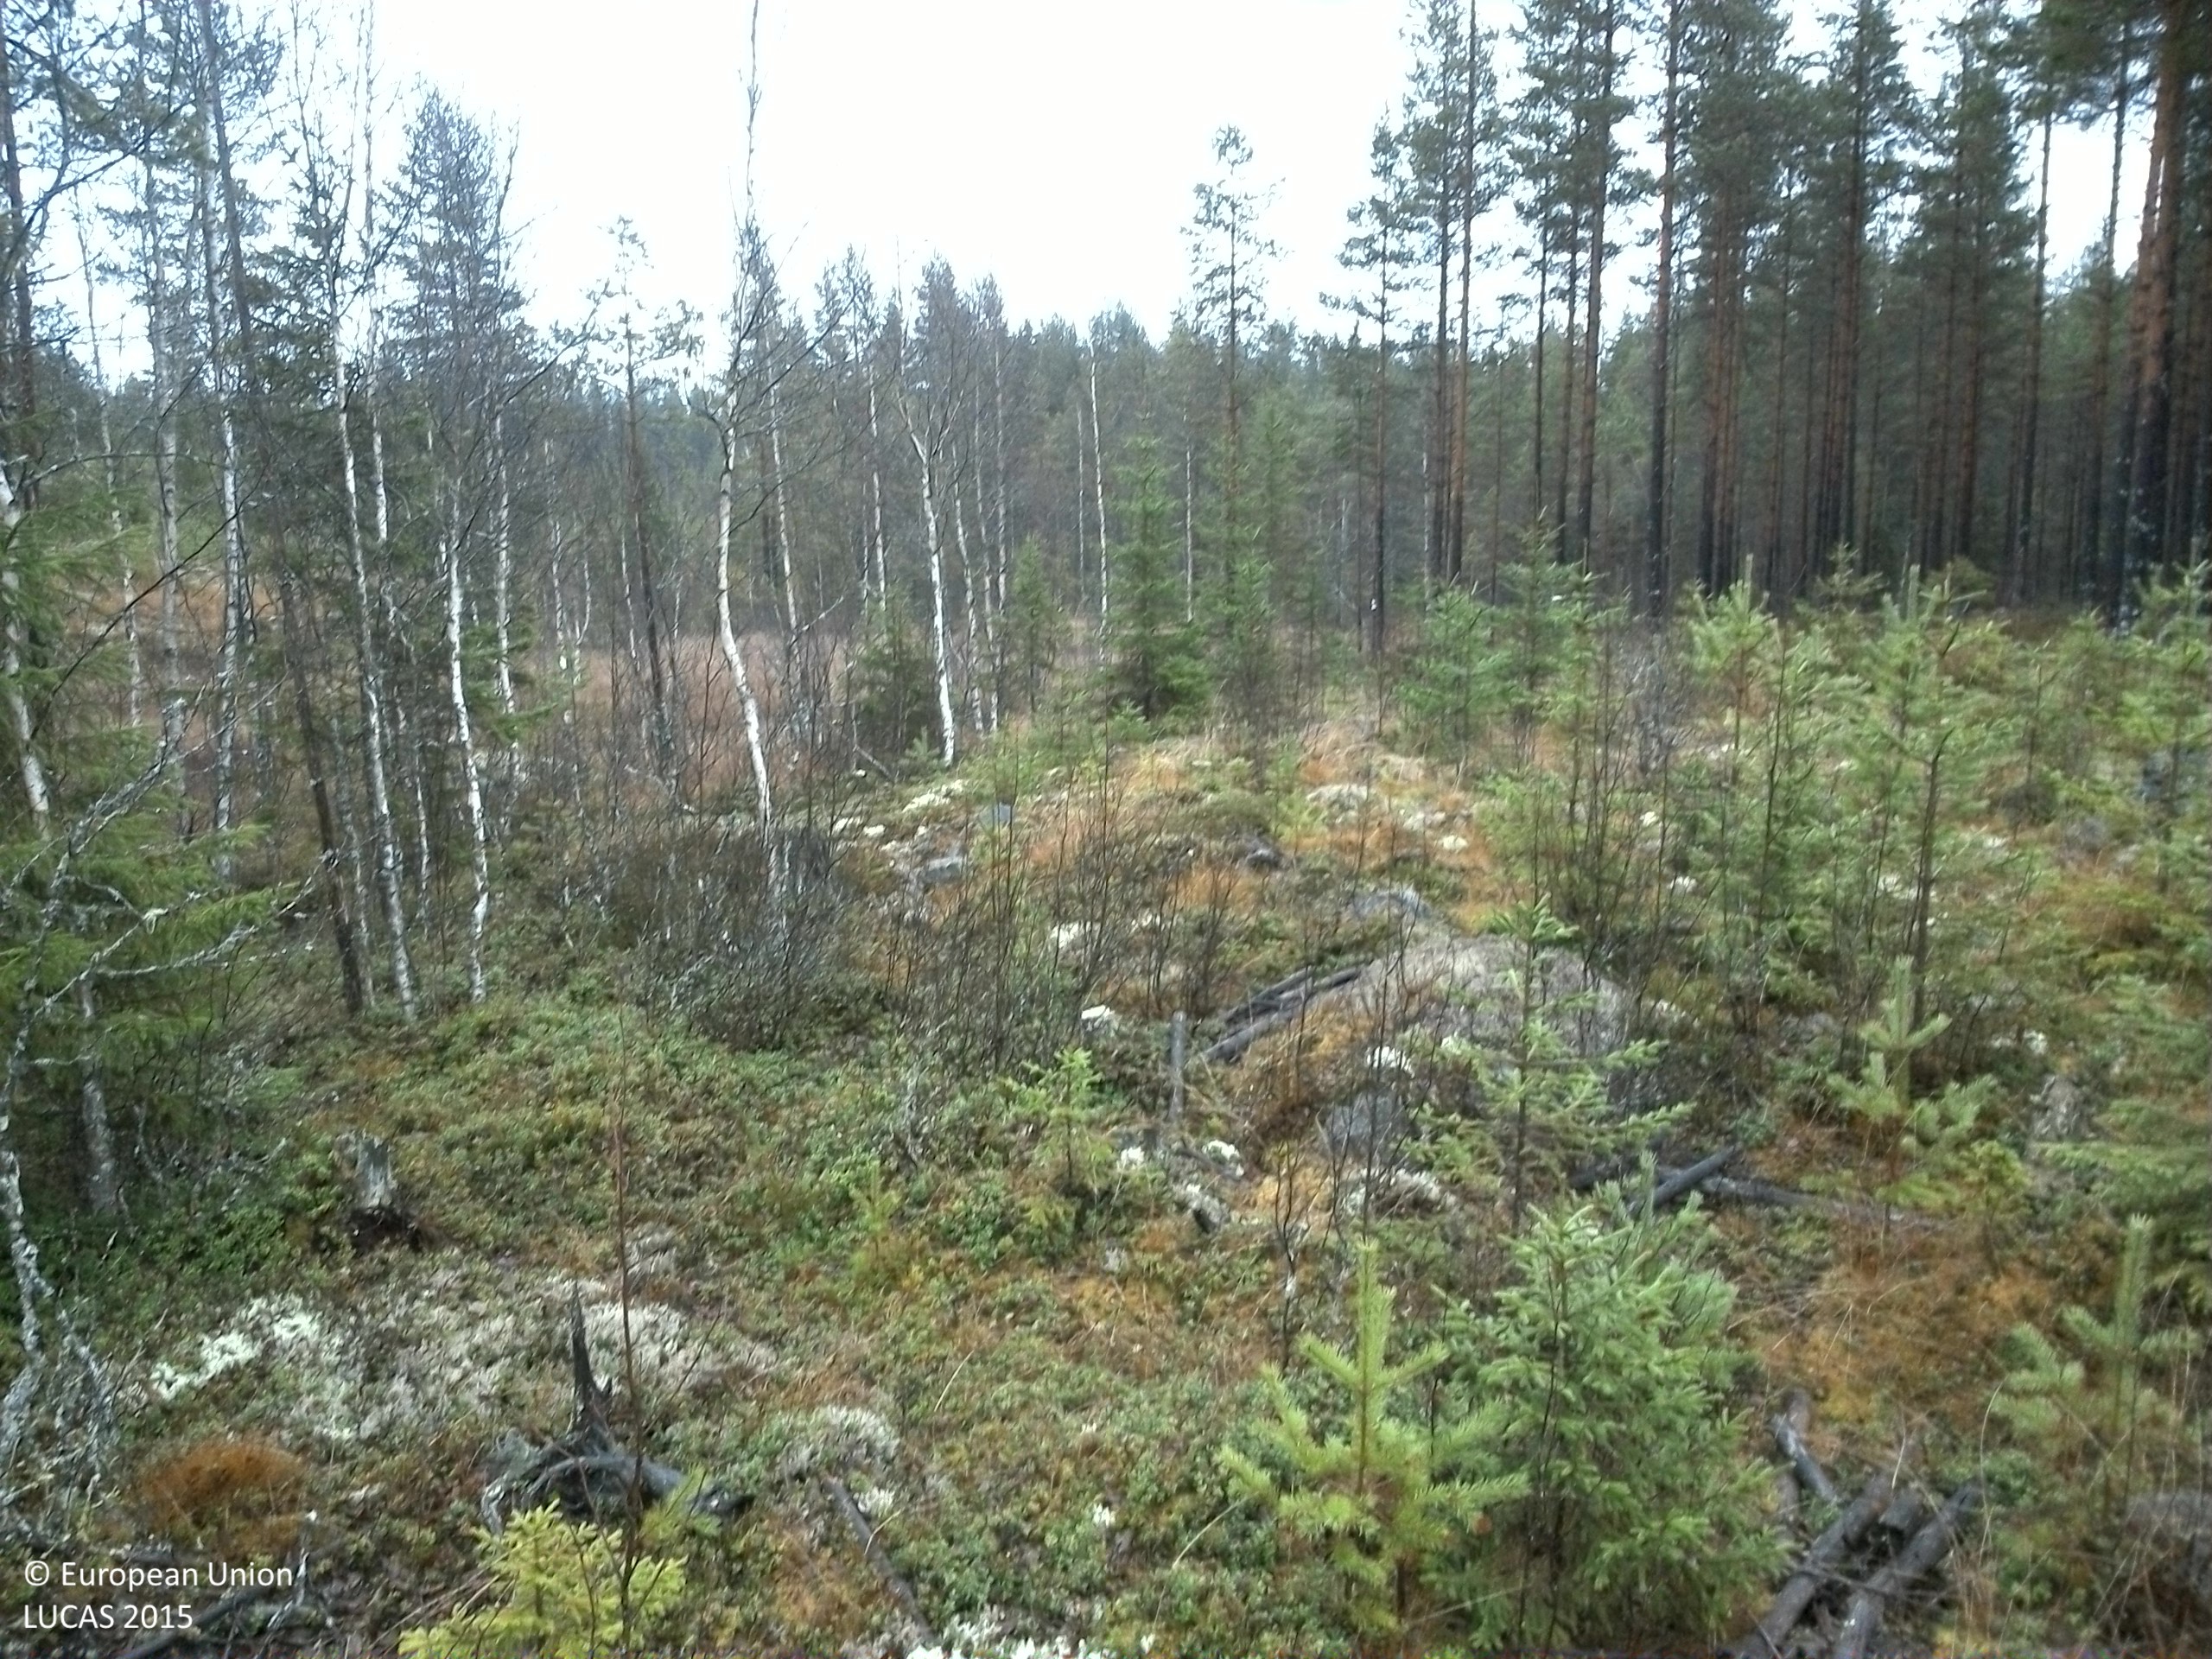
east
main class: Woodland
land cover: Other mixed woodland
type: boreal forest
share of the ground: 50 - 75 %
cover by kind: coniferous forest trees 35 %, broadleaved forest trees 30 %, shrubs 20 %, herbaceous plants 5 %, lichens and mosses 5 %, consolidated bare surface 5 %
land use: Forestry
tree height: < 5 m
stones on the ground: 10 - 25 %
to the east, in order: Other mixed woodland; Pine dominated mixed woodland; Other coniferous woodland; Spruce dominated mixed woodland; Other coniferous woodland; Pine dominated coniferous woodland
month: November
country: SE
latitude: 59.9749
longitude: 14.7374
